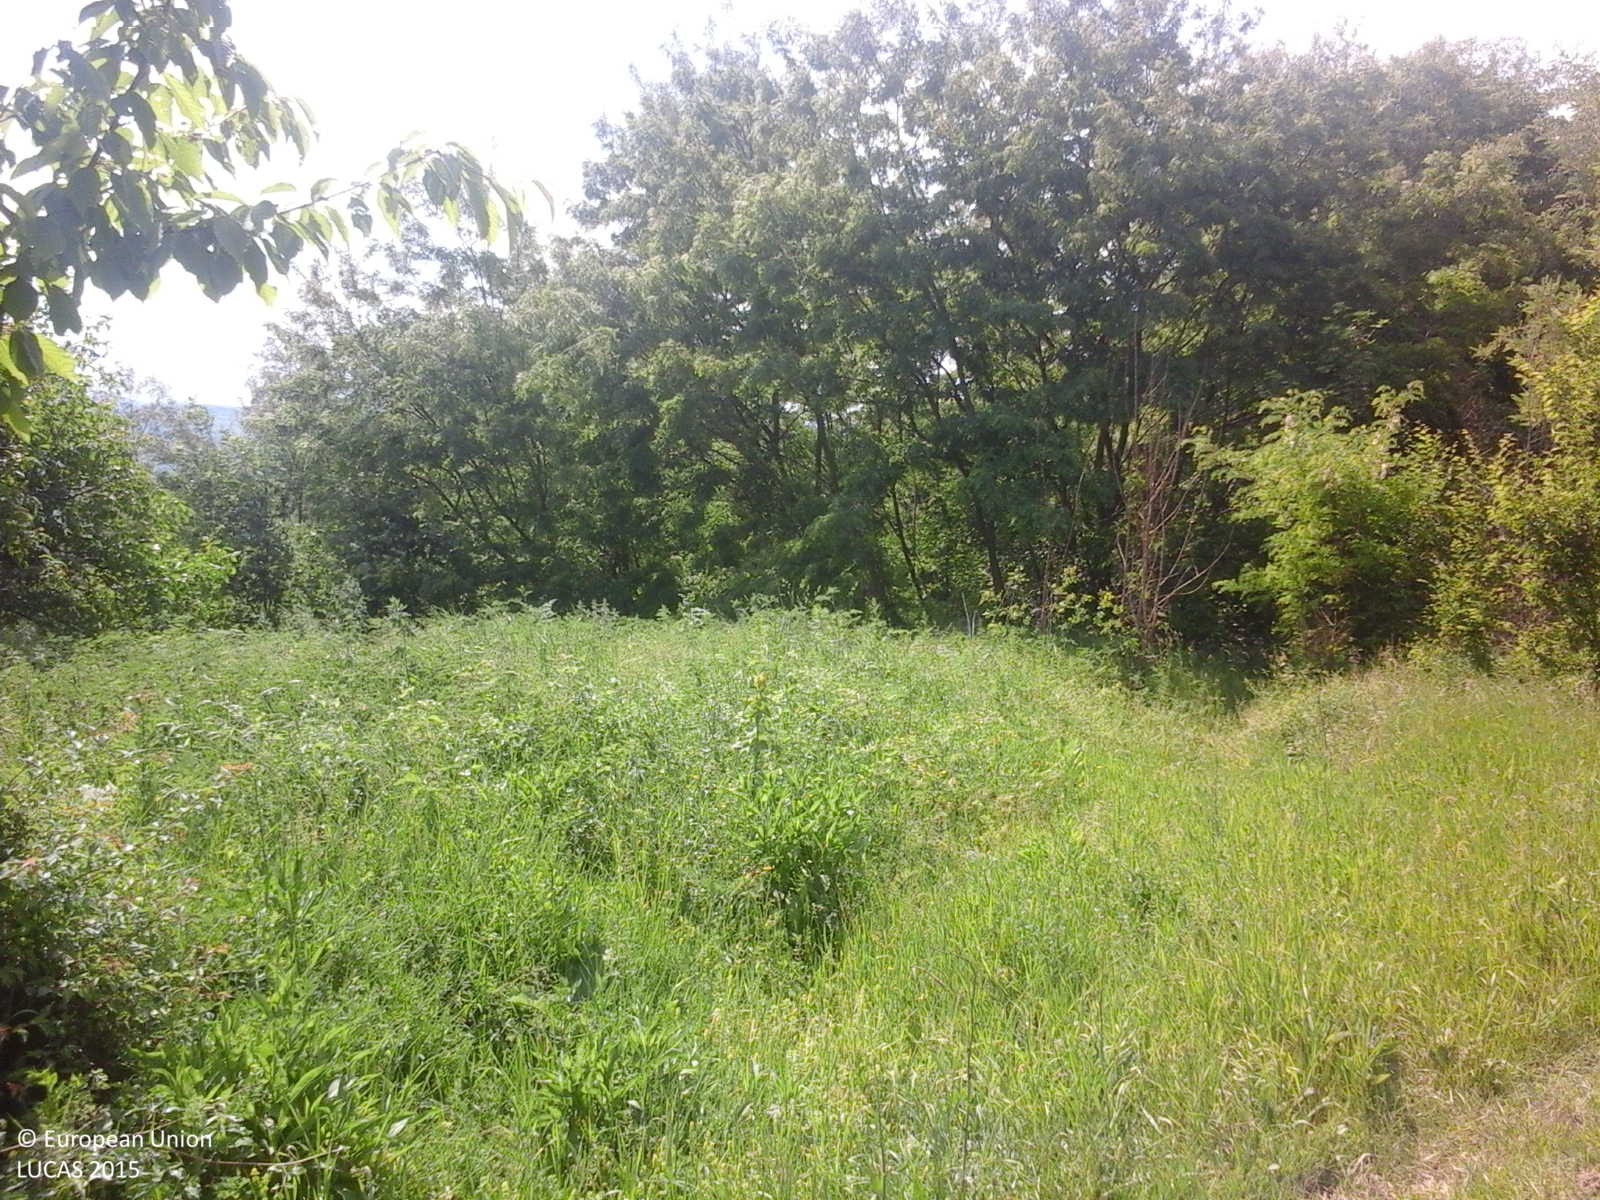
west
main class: Grassland
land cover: Grassland without tree/shrub cover
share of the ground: > 75 %
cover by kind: herbaceous plants 100 %
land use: Agriculture (excluding fallow land and kitchen gardens)
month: June
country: RO
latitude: 46.7251
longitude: 26.5314
